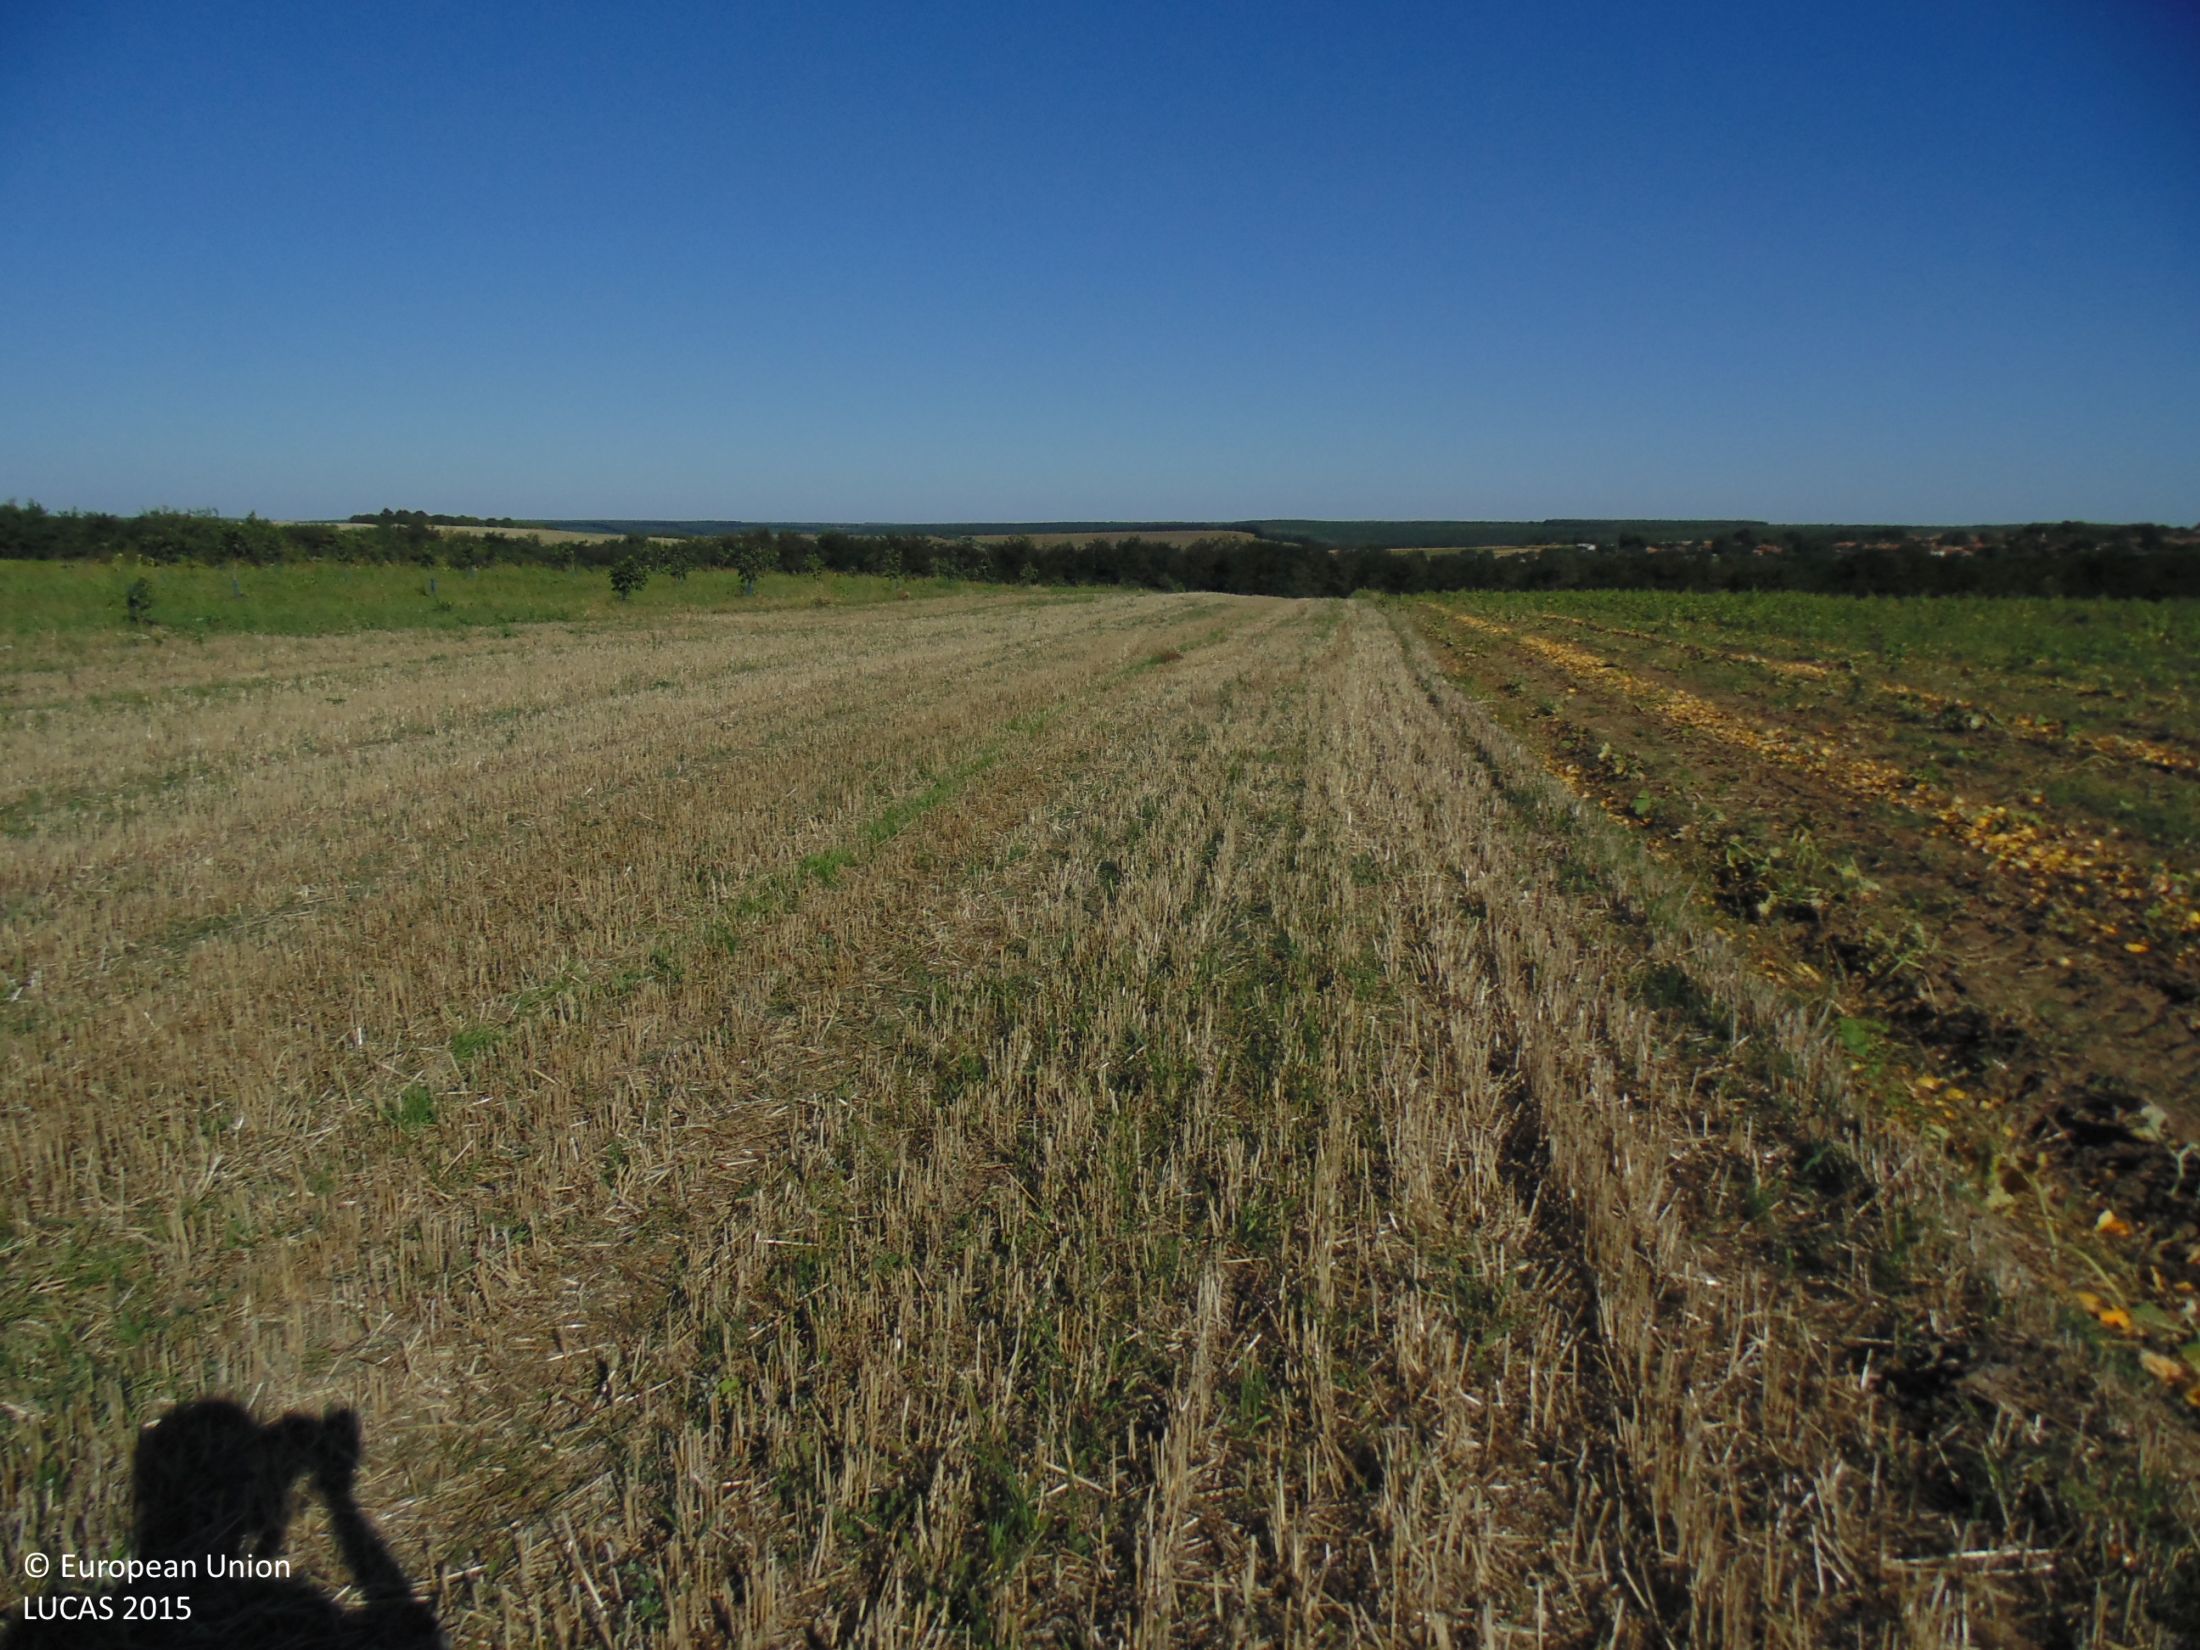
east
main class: Cropland
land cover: Common wheat
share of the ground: 25 - 50 %
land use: Agriculture (excluding fallow land and kitchen gardens)
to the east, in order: Common wheat; Grass margins; Nuts trees; Grass margins; Broadleaved woodland
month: September
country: BG
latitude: 43.8220
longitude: 27.1981
